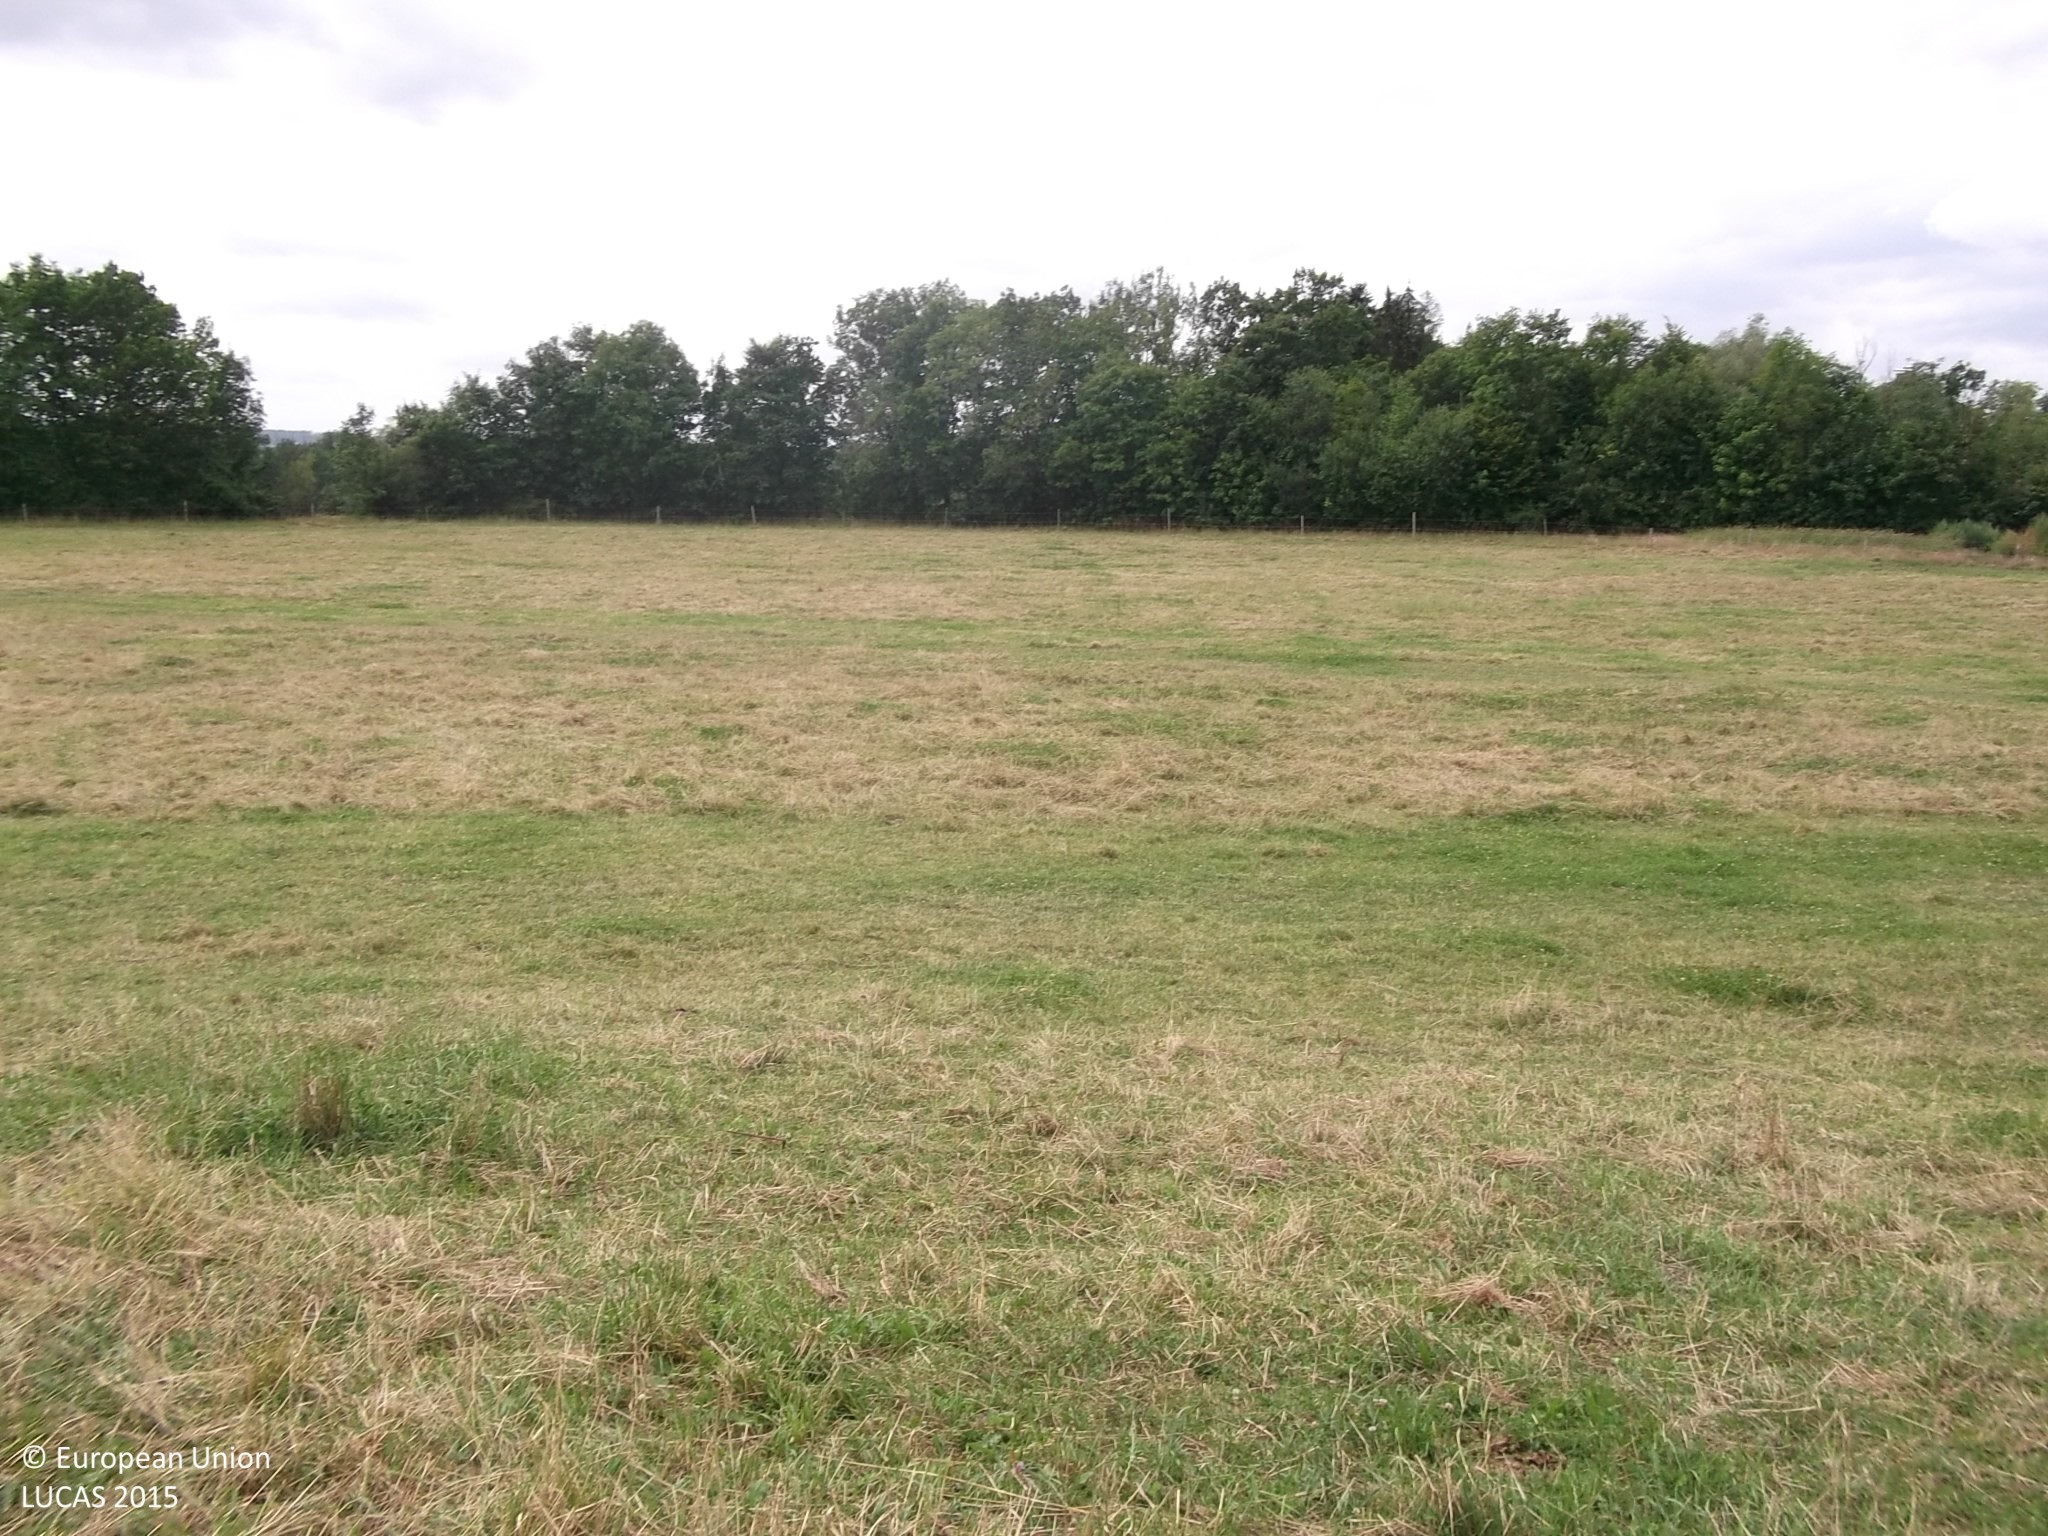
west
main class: Grassland
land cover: Grassland without tree/shrub cover
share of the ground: > 75 %
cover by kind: herbaceous plants 100 %
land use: Agriculture (excluding fallow land and kitchen gardens)
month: July
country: AT
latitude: 48.0432
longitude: 12.8291
